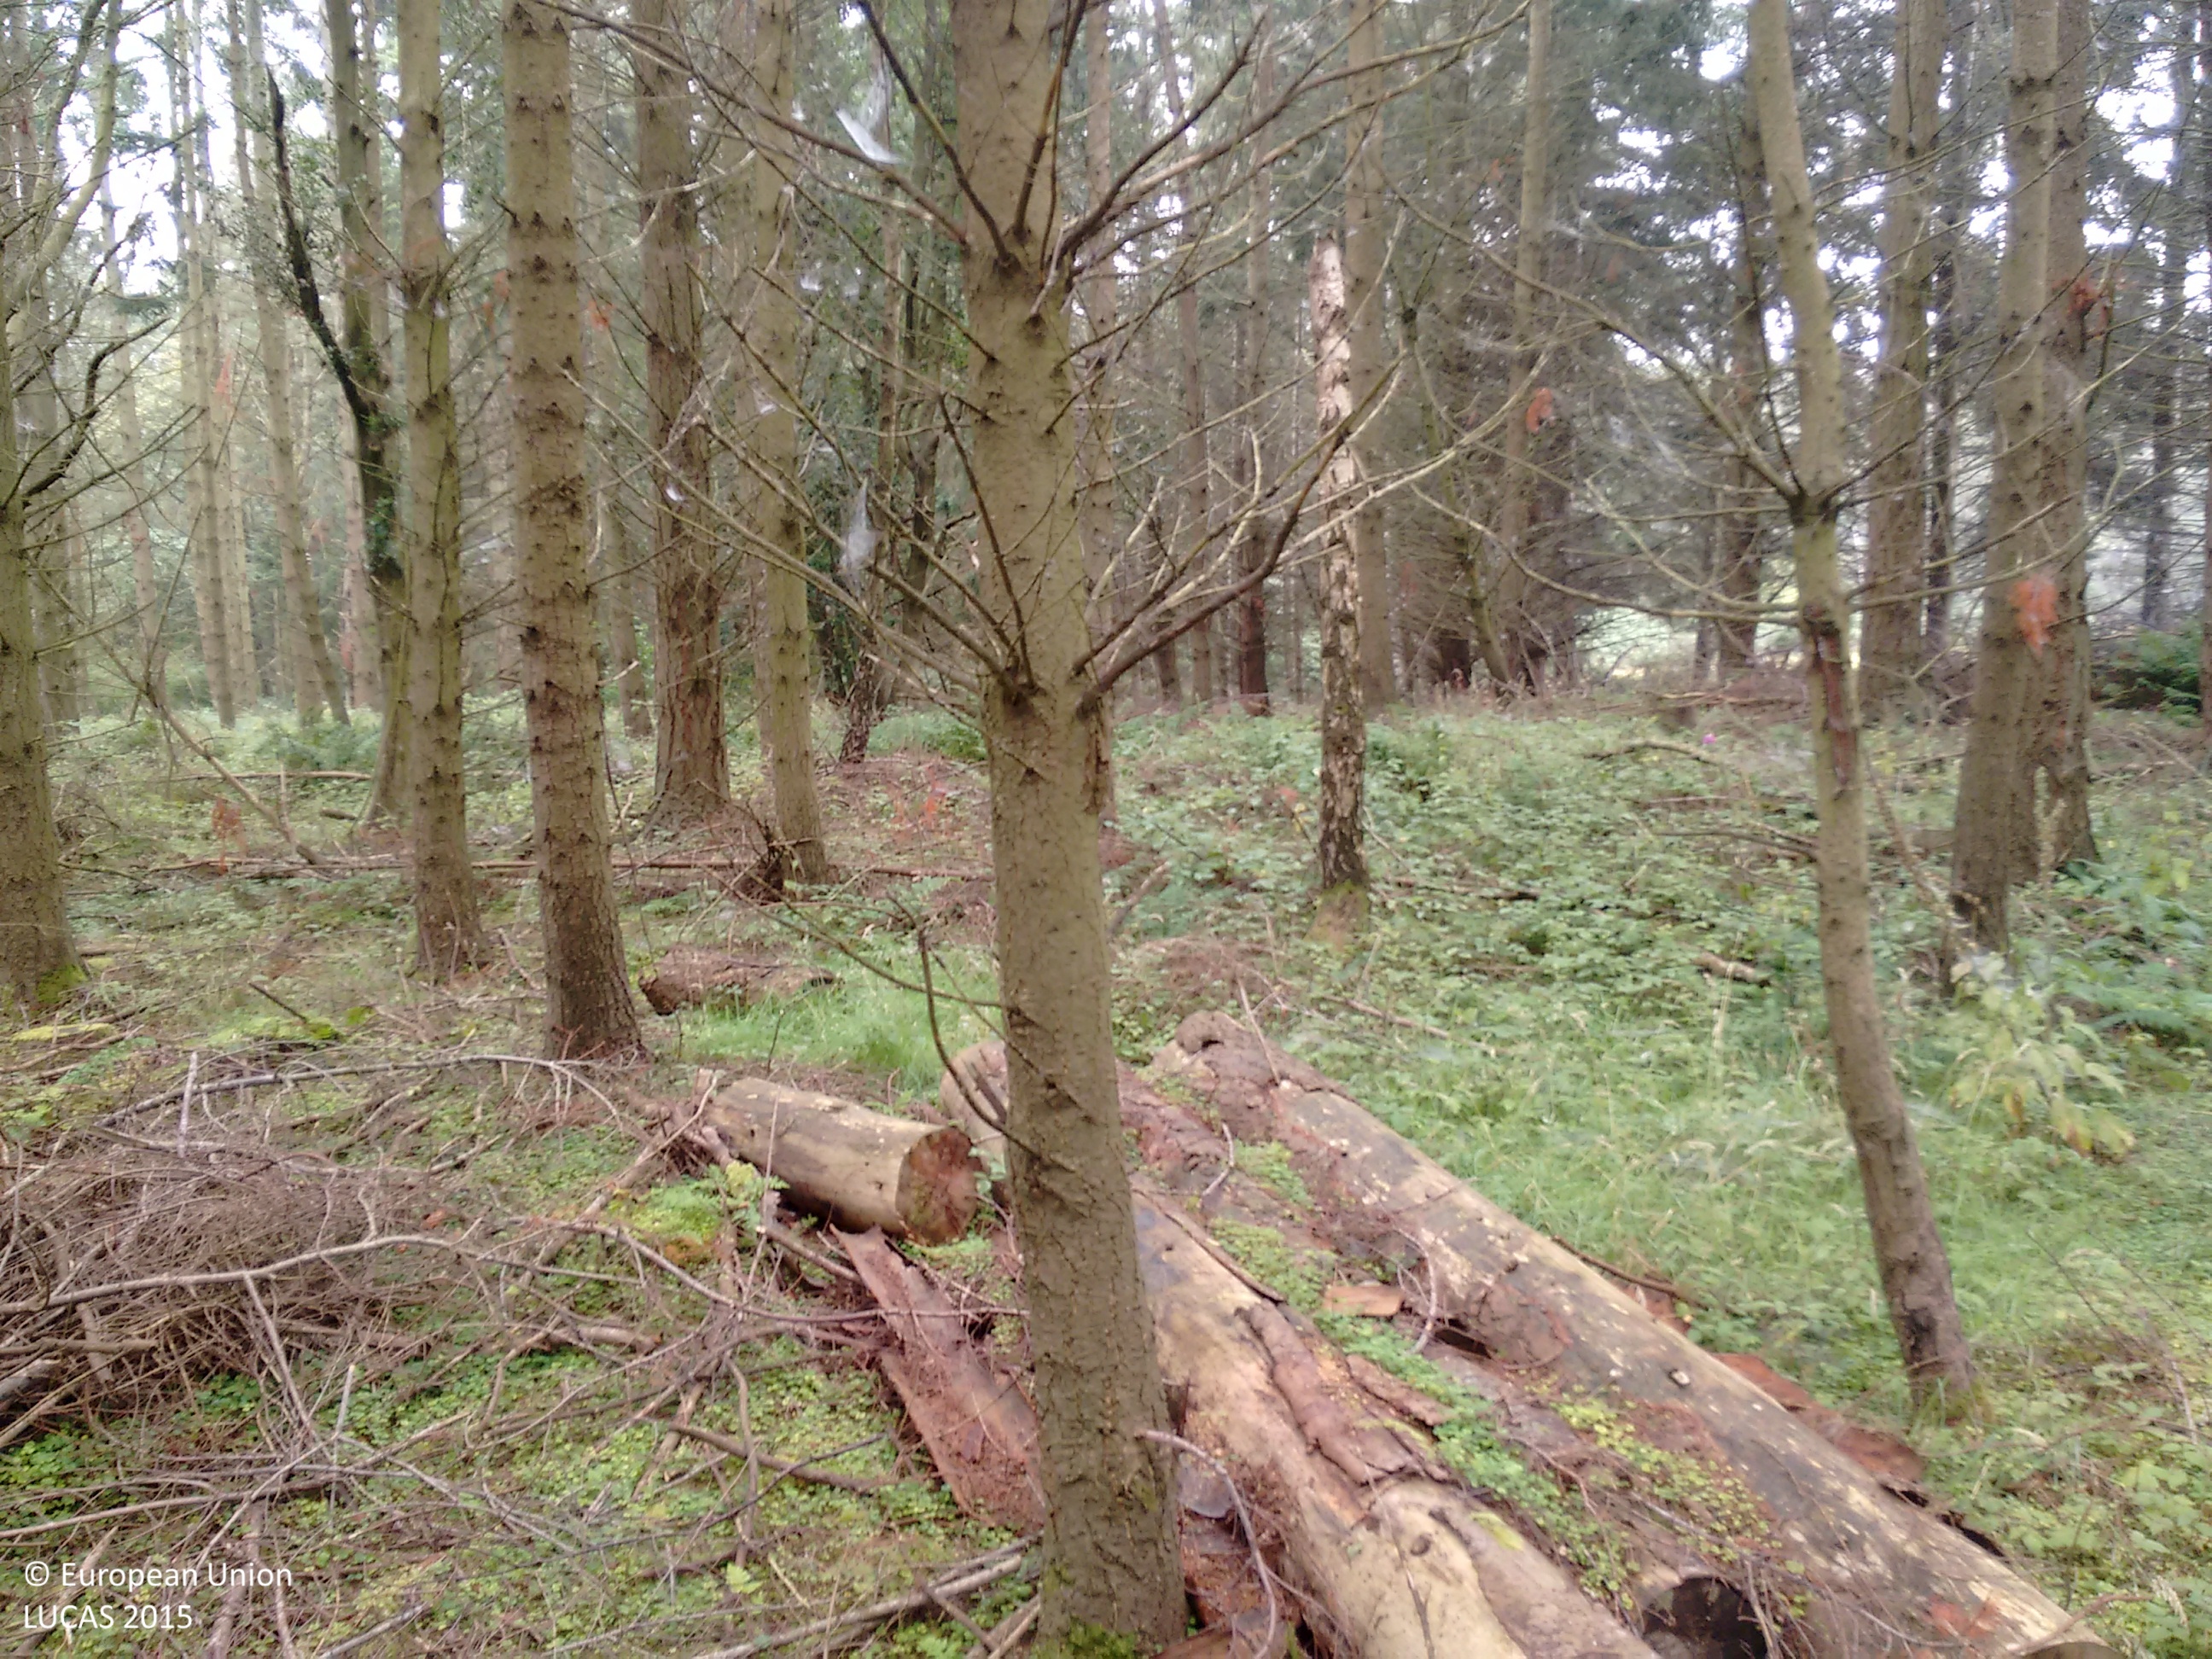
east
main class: Woodland
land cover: Spruce dominated coniferous woodland
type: exotic forest
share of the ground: > 75 %
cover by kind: coniferous forest trees 80 %, herbaceous plants 10 %, broadleaved forest trees 5 %, lichens and mosses 5 %
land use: Forestry
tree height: > 5 m
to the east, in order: Spruce dominated coniferous woodland; Other coniferous woodland; Fences; Grass margins; Barley; Fences; Grassland without tree/shrub cover; Fences; Other mixed woodland; Fences; Barley
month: September
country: GB
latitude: 57.5300
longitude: -3.8895
